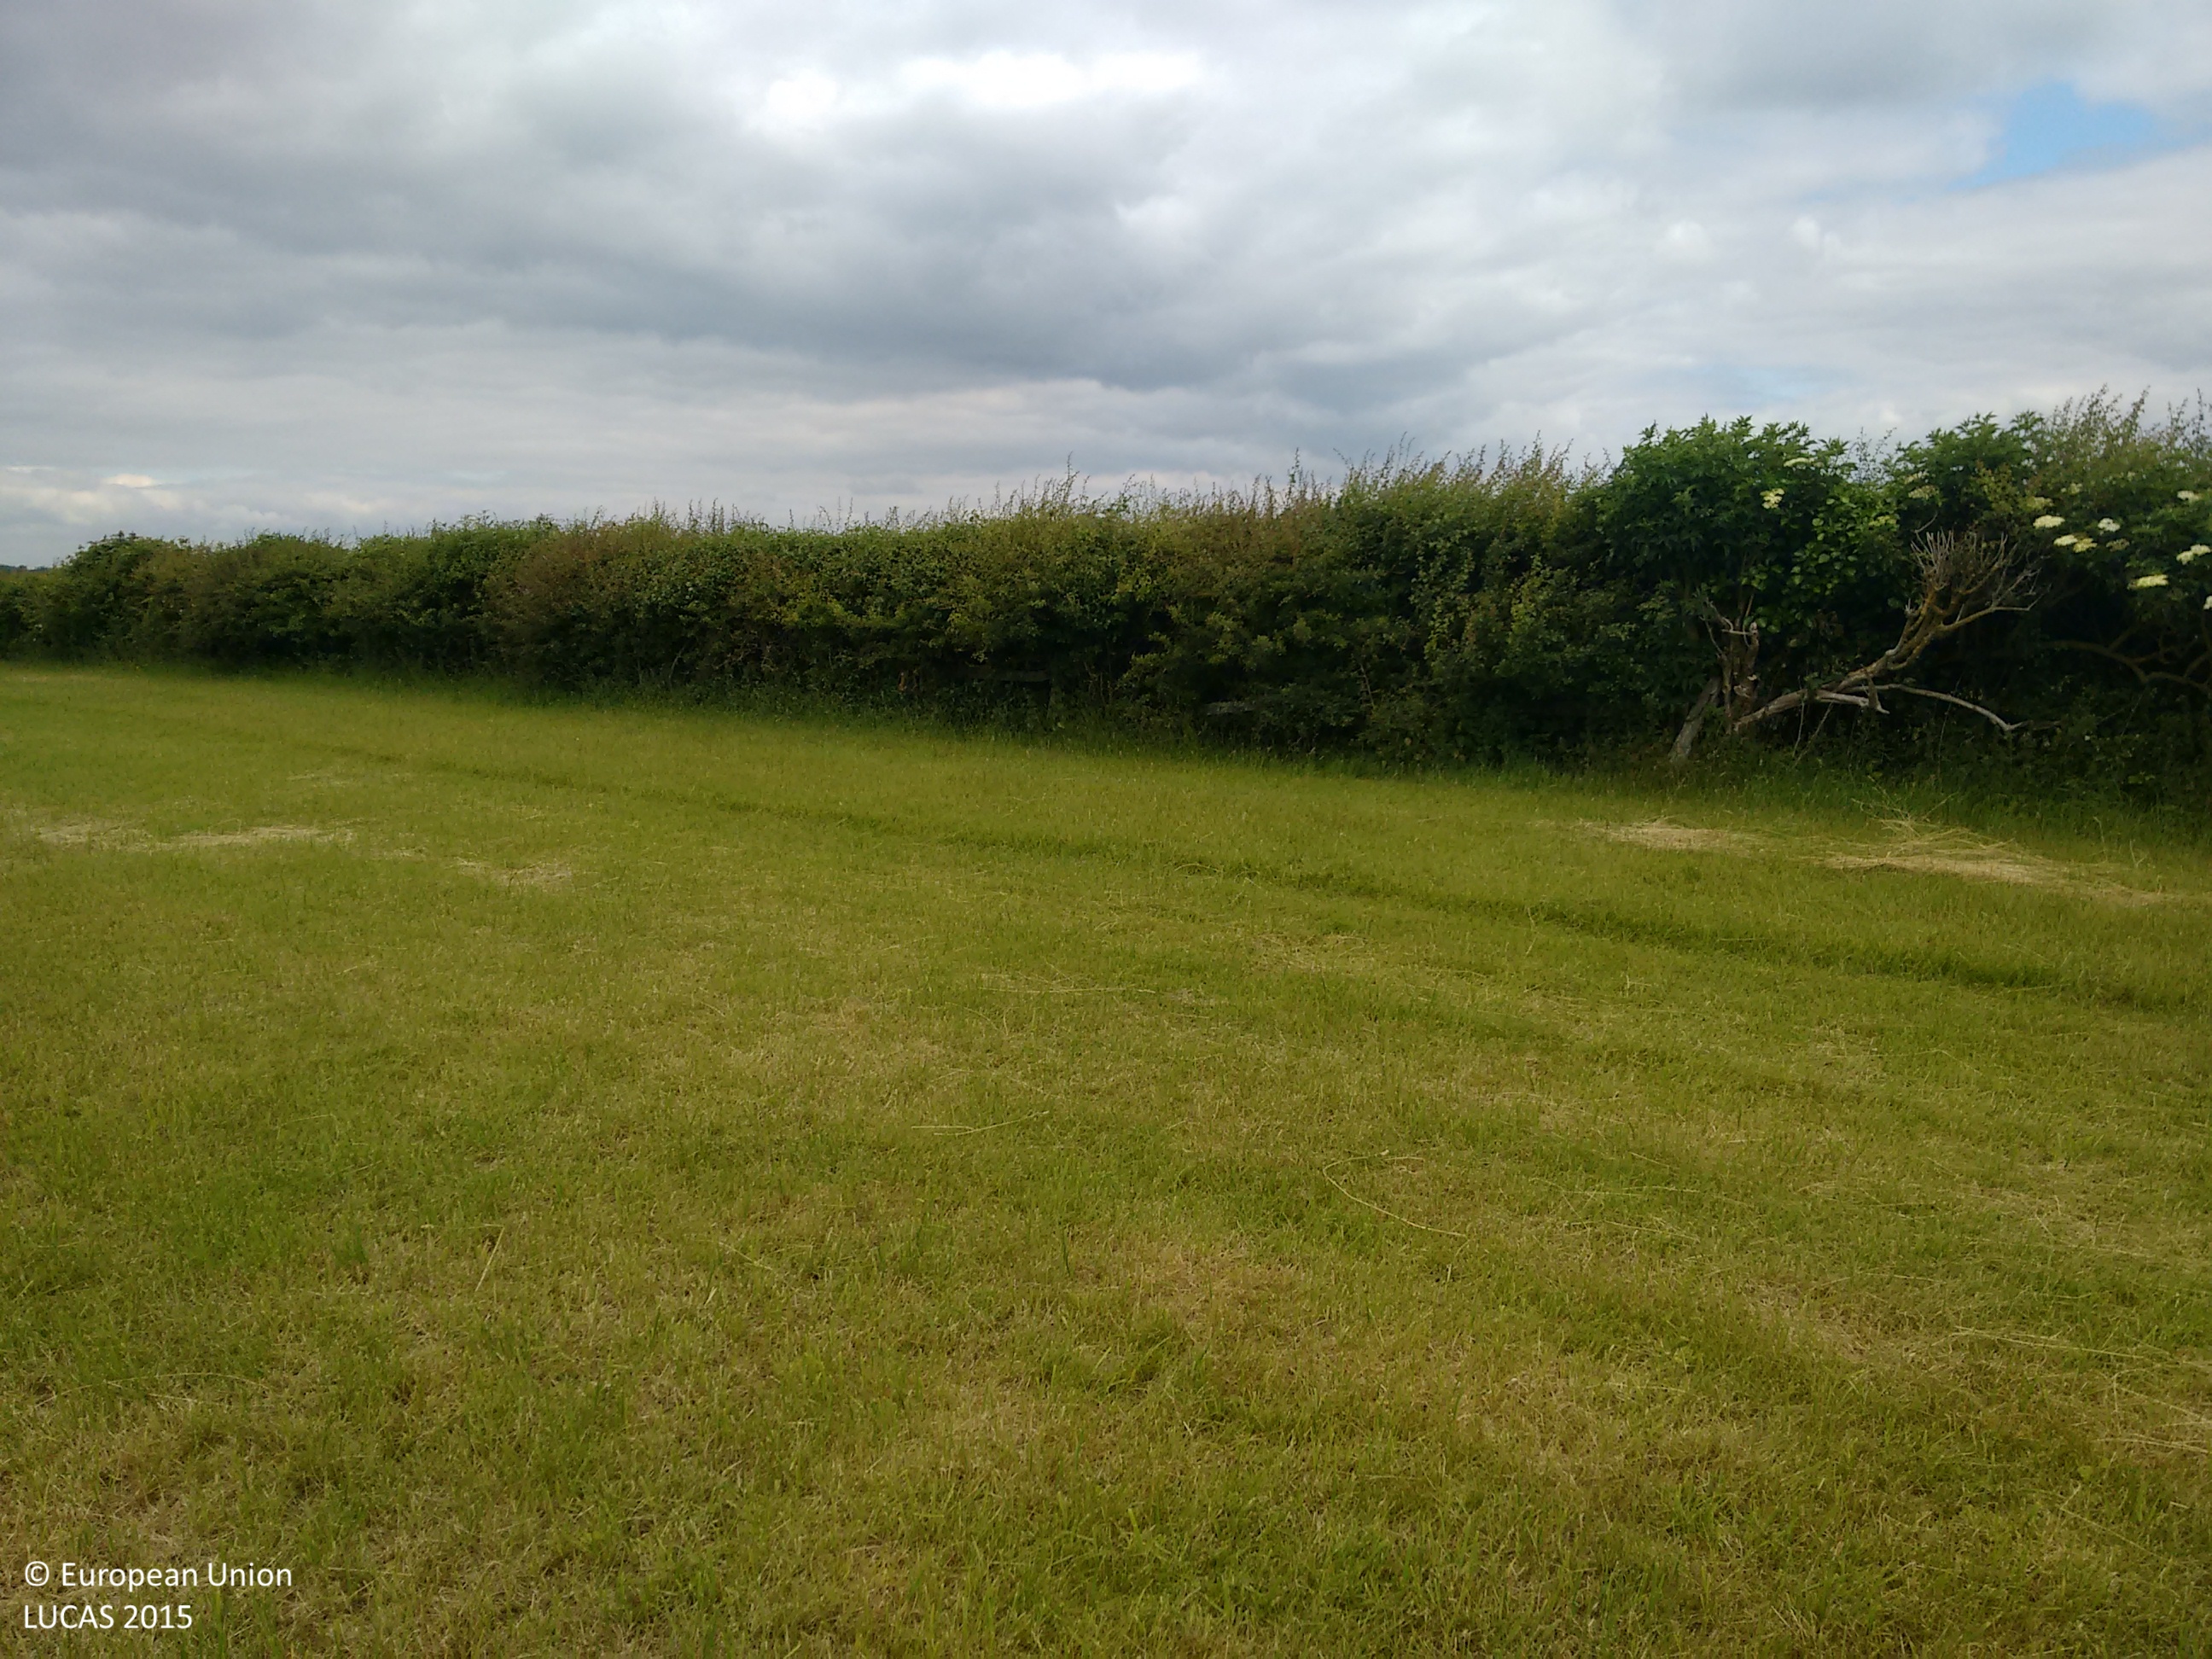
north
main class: Grassland
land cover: Grassland without tree/shrub cover
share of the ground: > 75 %
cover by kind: herbaceous plants 100 %
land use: Agriculture (excluding fallow land and kitchen gardens)
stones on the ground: < 10 %
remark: Harvested field
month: June
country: GB
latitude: 50.9007
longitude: -0.0292
